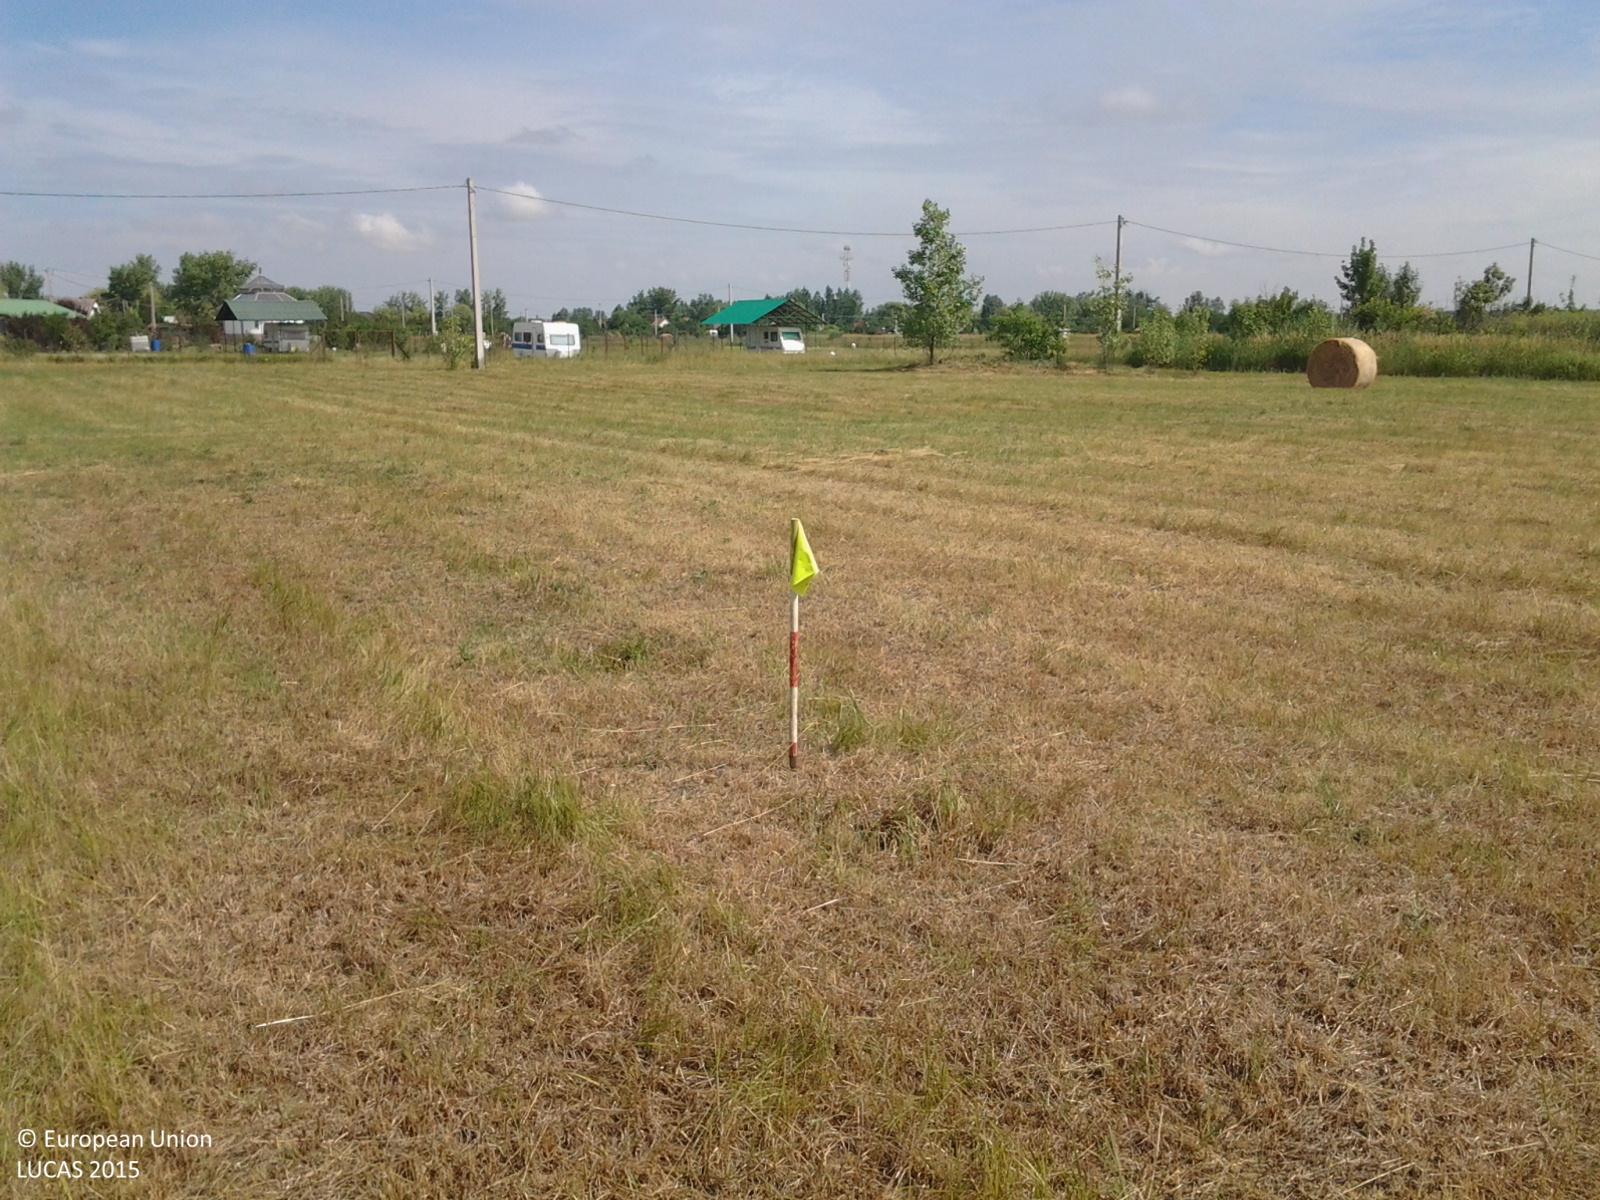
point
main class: Grassland
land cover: Grassland without tree/shrub cover
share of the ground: > 75 %
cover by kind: herbaceous plants 100 %
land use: Agriculture (excluding fallow land and kitchen gardens)
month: June
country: HU
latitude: 47.0824
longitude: 20.1545
